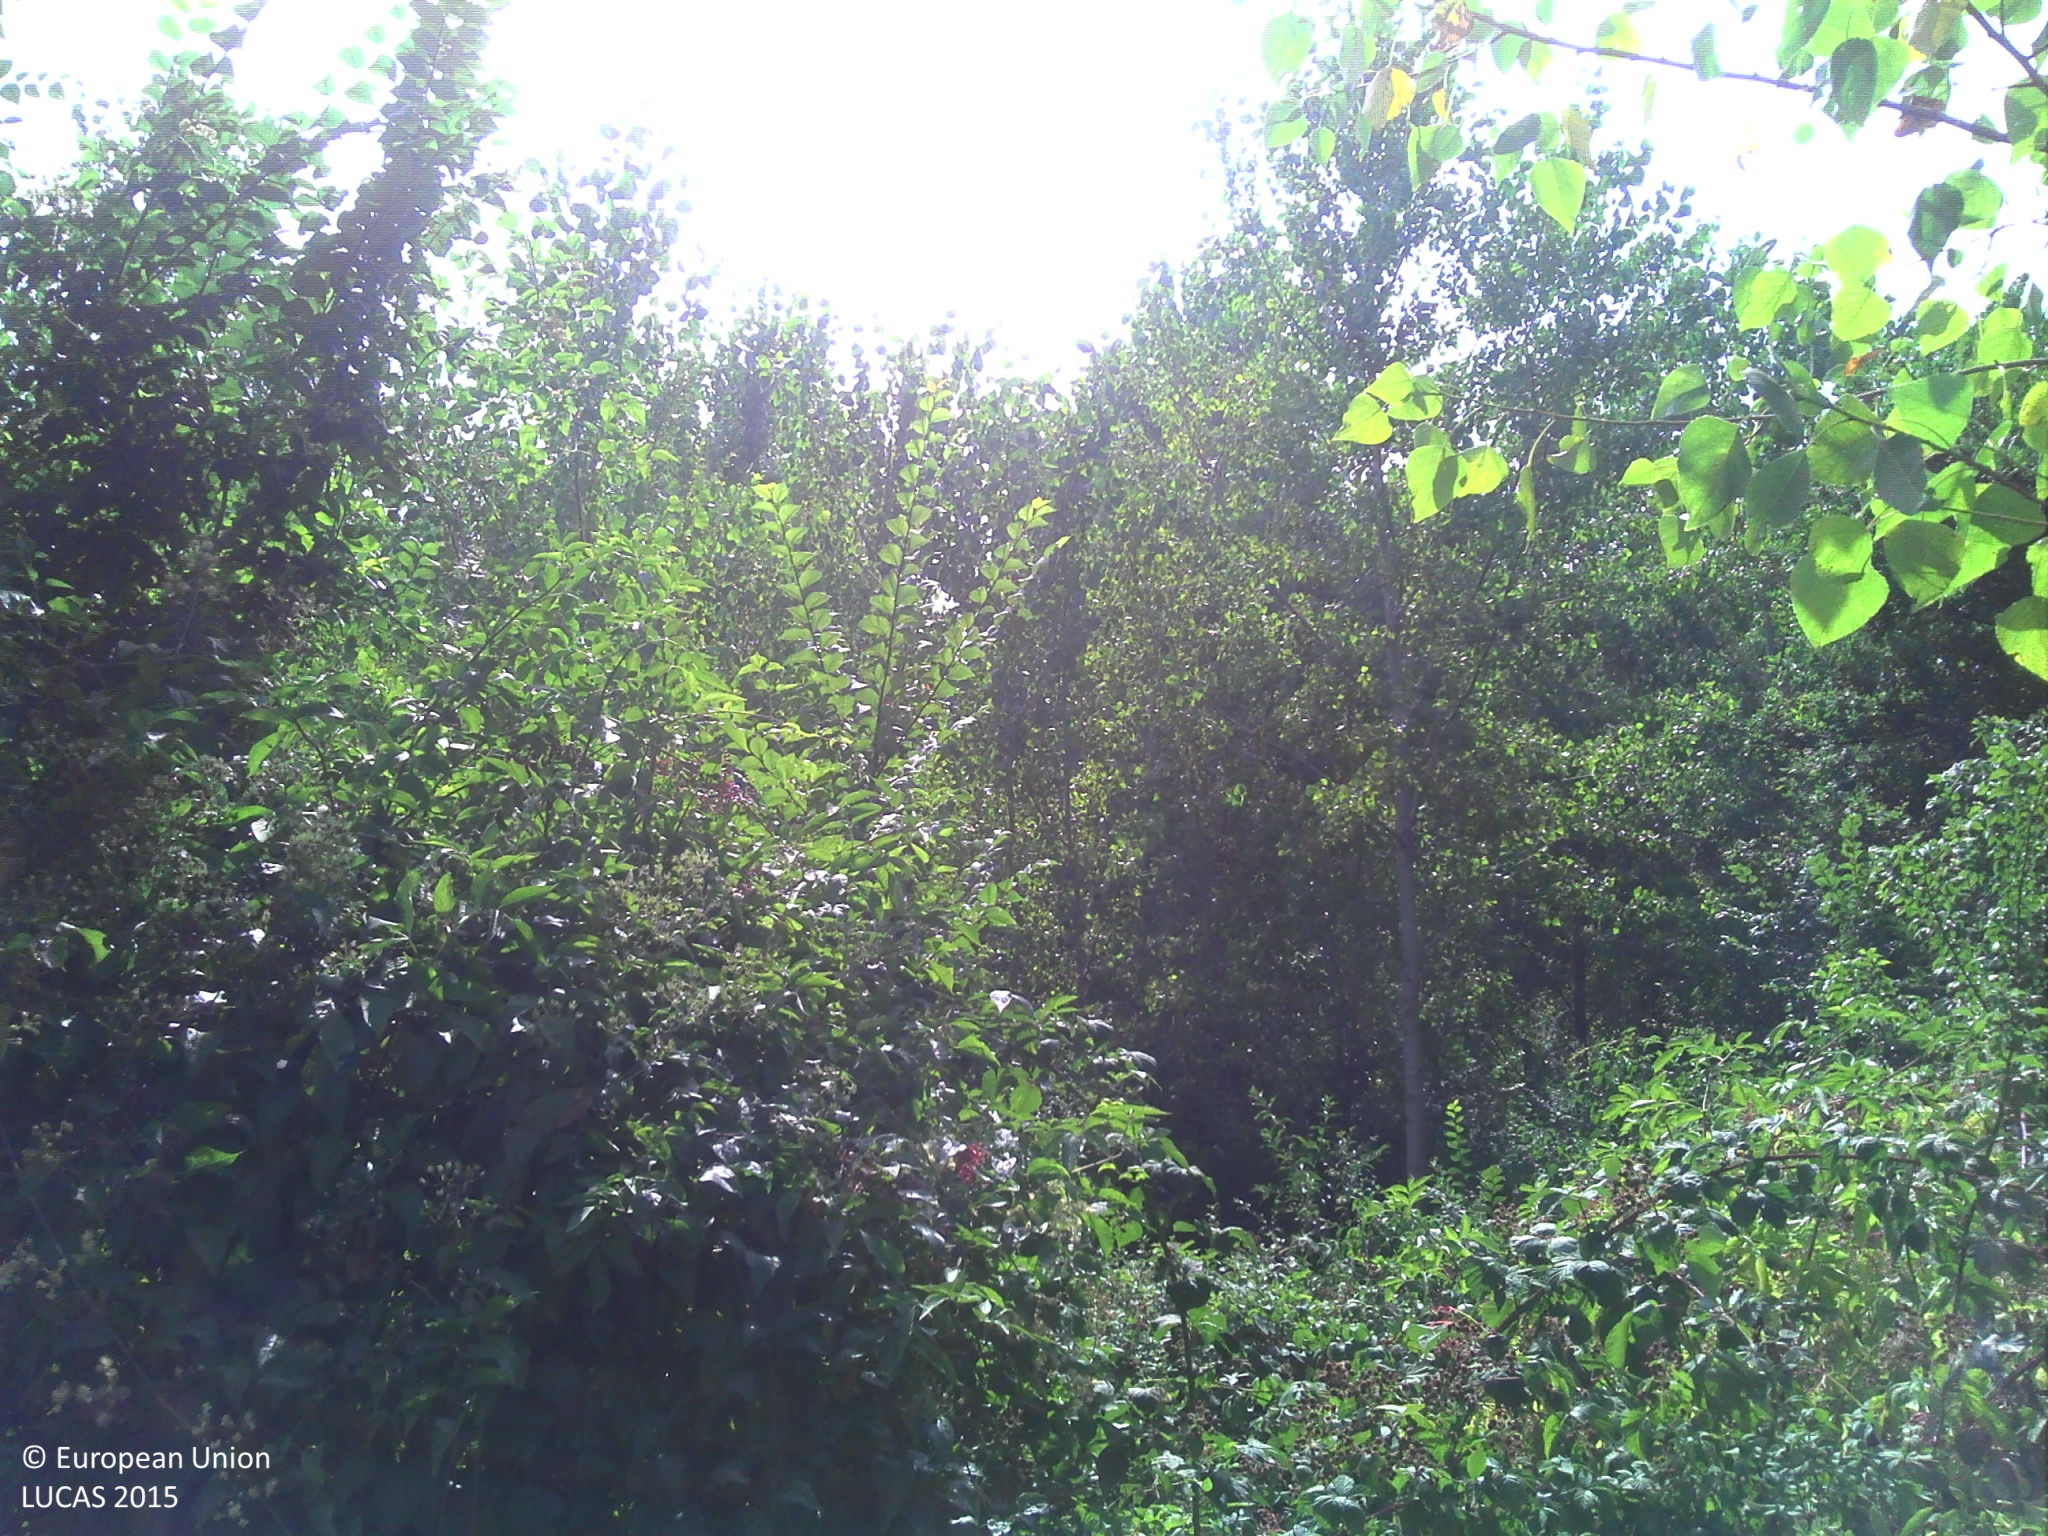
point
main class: Woodland
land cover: Broadleaved woodland
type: exotic forest
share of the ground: > 75 %
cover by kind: broadleaved forest trees 55 %, herbaceous plants 15 %, lichens and mosses 15 %, unconsolidated bare surface 5 %
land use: Forestry
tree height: > 5 m
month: August
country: FR
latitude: 48.6890
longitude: 3.3231
